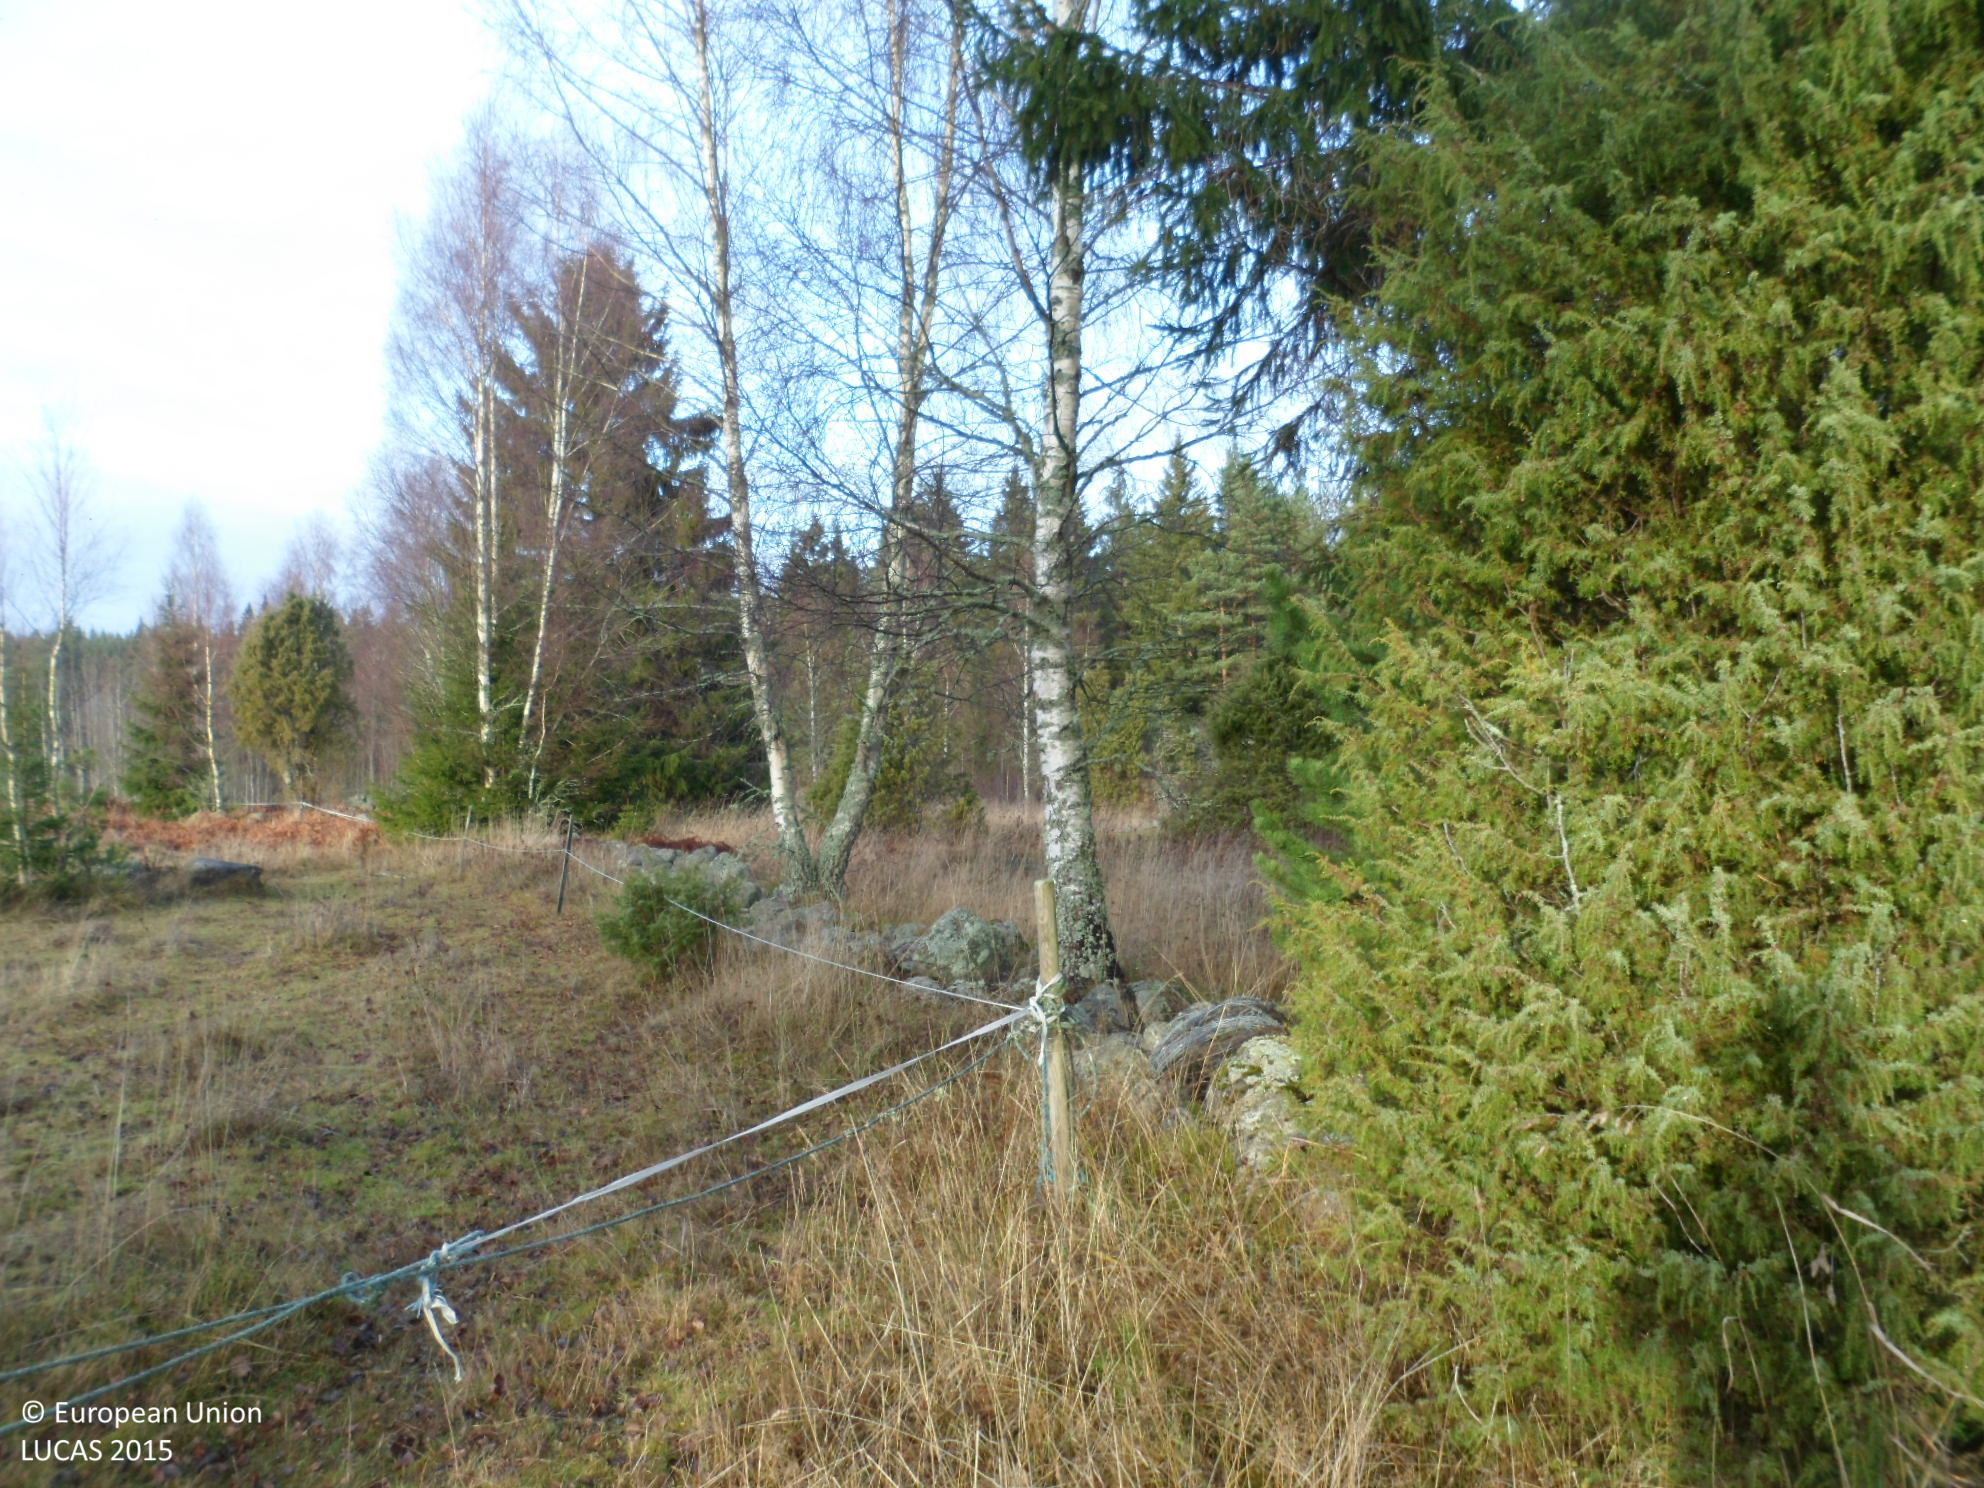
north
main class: Woodland
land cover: Broadleaved woodland
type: hemiboreal forest and nemoral coniferous forest and mixed broadleaved-coniferous forest
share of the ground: 10 - 25 %
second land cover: Grassland without tree/shrub cover
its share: > 75 %
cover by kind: herbaceous plants 55 %, broadleaved forest trees 20 %, shrubs 15 %, coniferous forest trees 5 %, lichens and mosses 5 %
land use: Forestry
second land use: Agriculture (excluding fallow land and kitchen gardens)
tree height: > 5 m
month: November
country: SE
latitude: 57.7468
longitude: 15.4900
